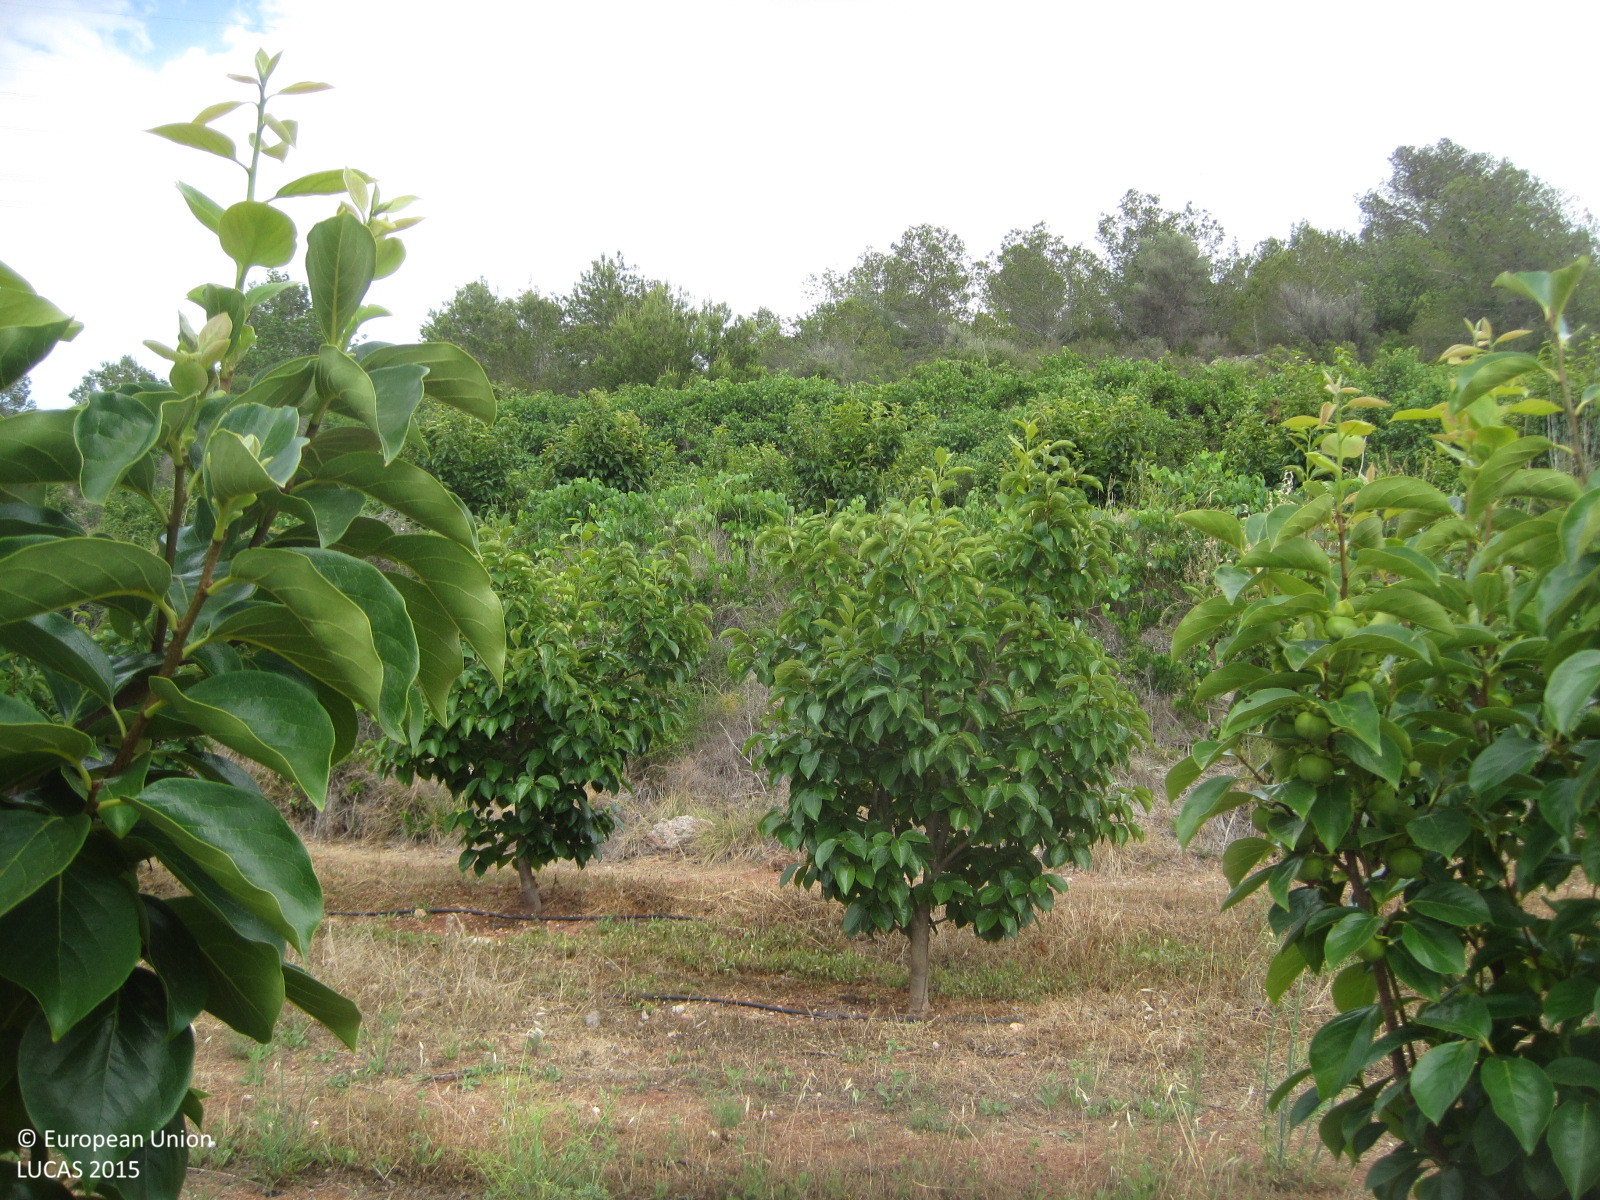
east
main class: Cropland
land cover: Other fruit trees and berries
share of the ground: 25 - 50 %
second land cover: Spontaneously vegetated surfaces
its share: > 75 %
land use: Agriculture (excluding fallow land and kitchen gardens)
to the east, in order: Other fruit trees and berries; Spontaneously vegetated surfaces; Shrubland without tree cover; Other fruit trees and berries; Shrubland without tree cover; Other fruit trees and berries; Pine dominated coniferous woodland; Dry stone walls; Pine dominated coniferous woodland; Dry stone walls; Pine dominated coniferous woodland; Dry stone walls; Pine dominated coniferous woodland; Dry stone walls; Pine dominated coniferous woodland; Dry stone walls; Electric lines; Shrubland with sparse tree cover; Shrubland without tree cover
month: June
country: ES
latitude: 39.2871
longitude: -0.6279
